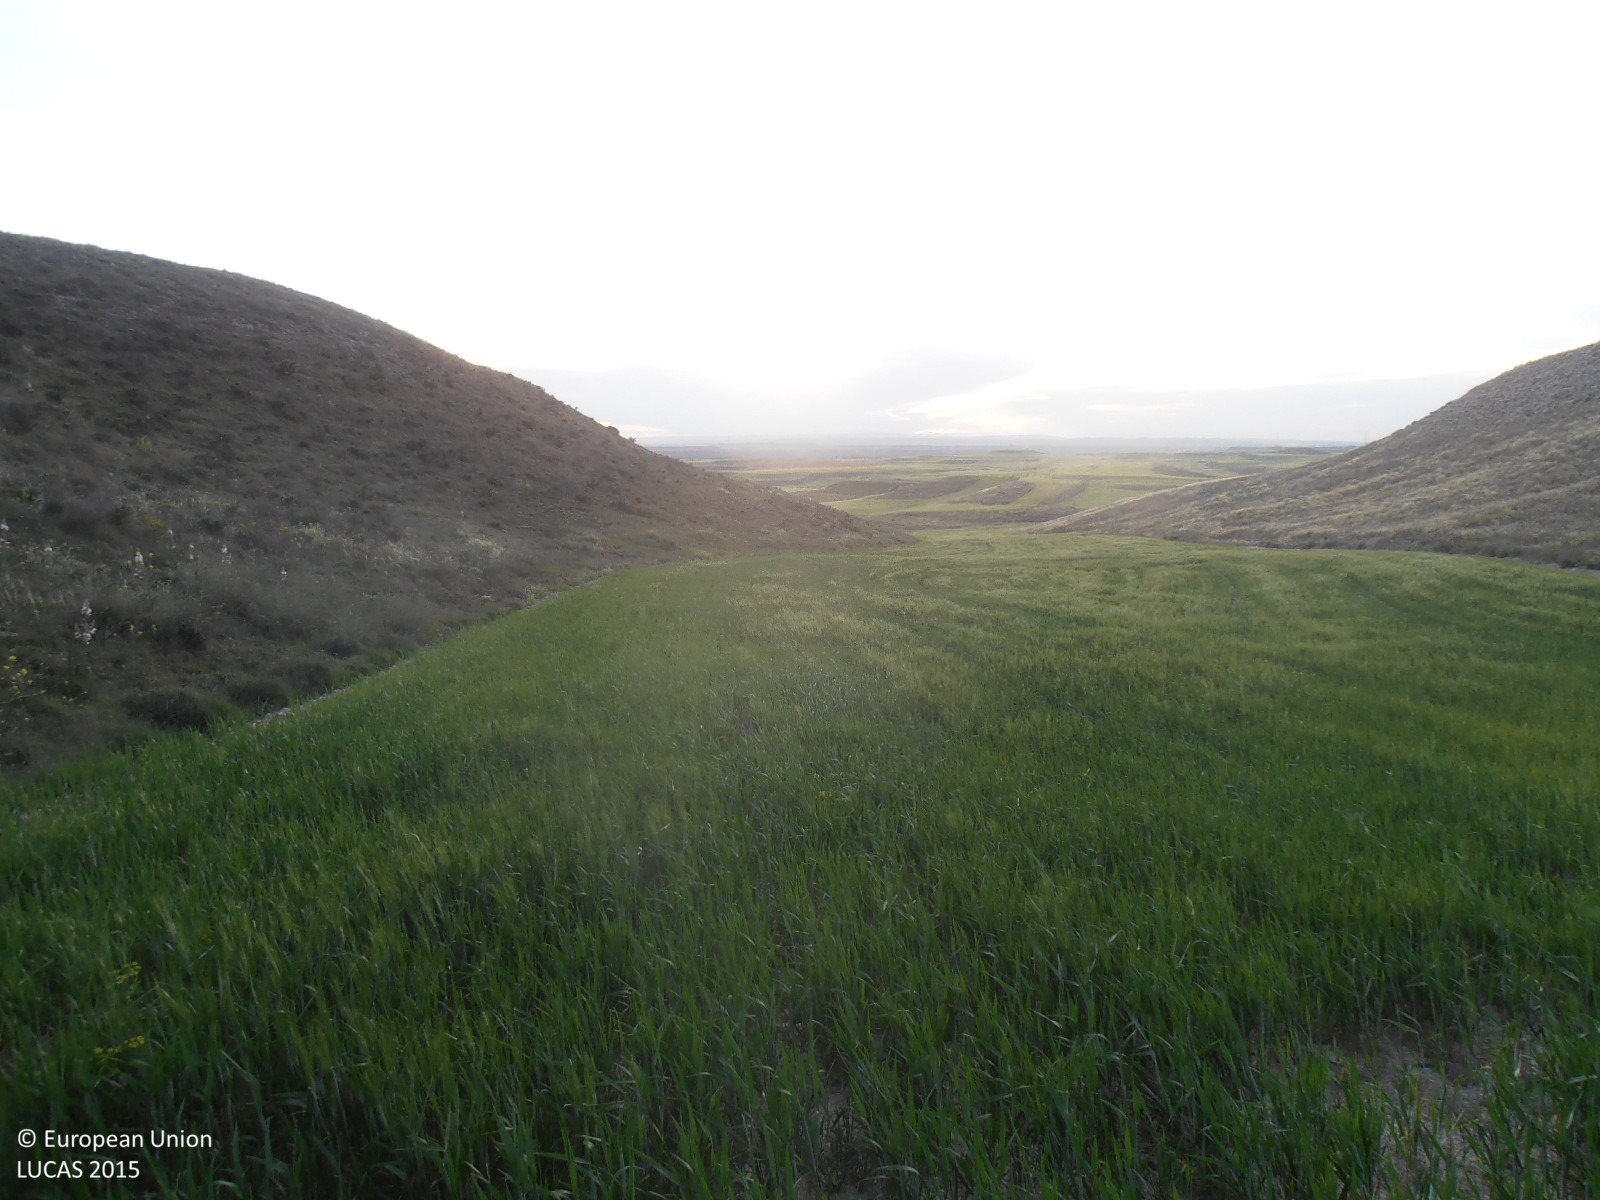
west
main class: Cropland
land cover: Durum wheat
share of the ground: > 75 %
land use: Agriculture (excluding fallow land and kitchen gardens)
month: April
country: ES
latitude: 41.3729
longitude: -0.3817
